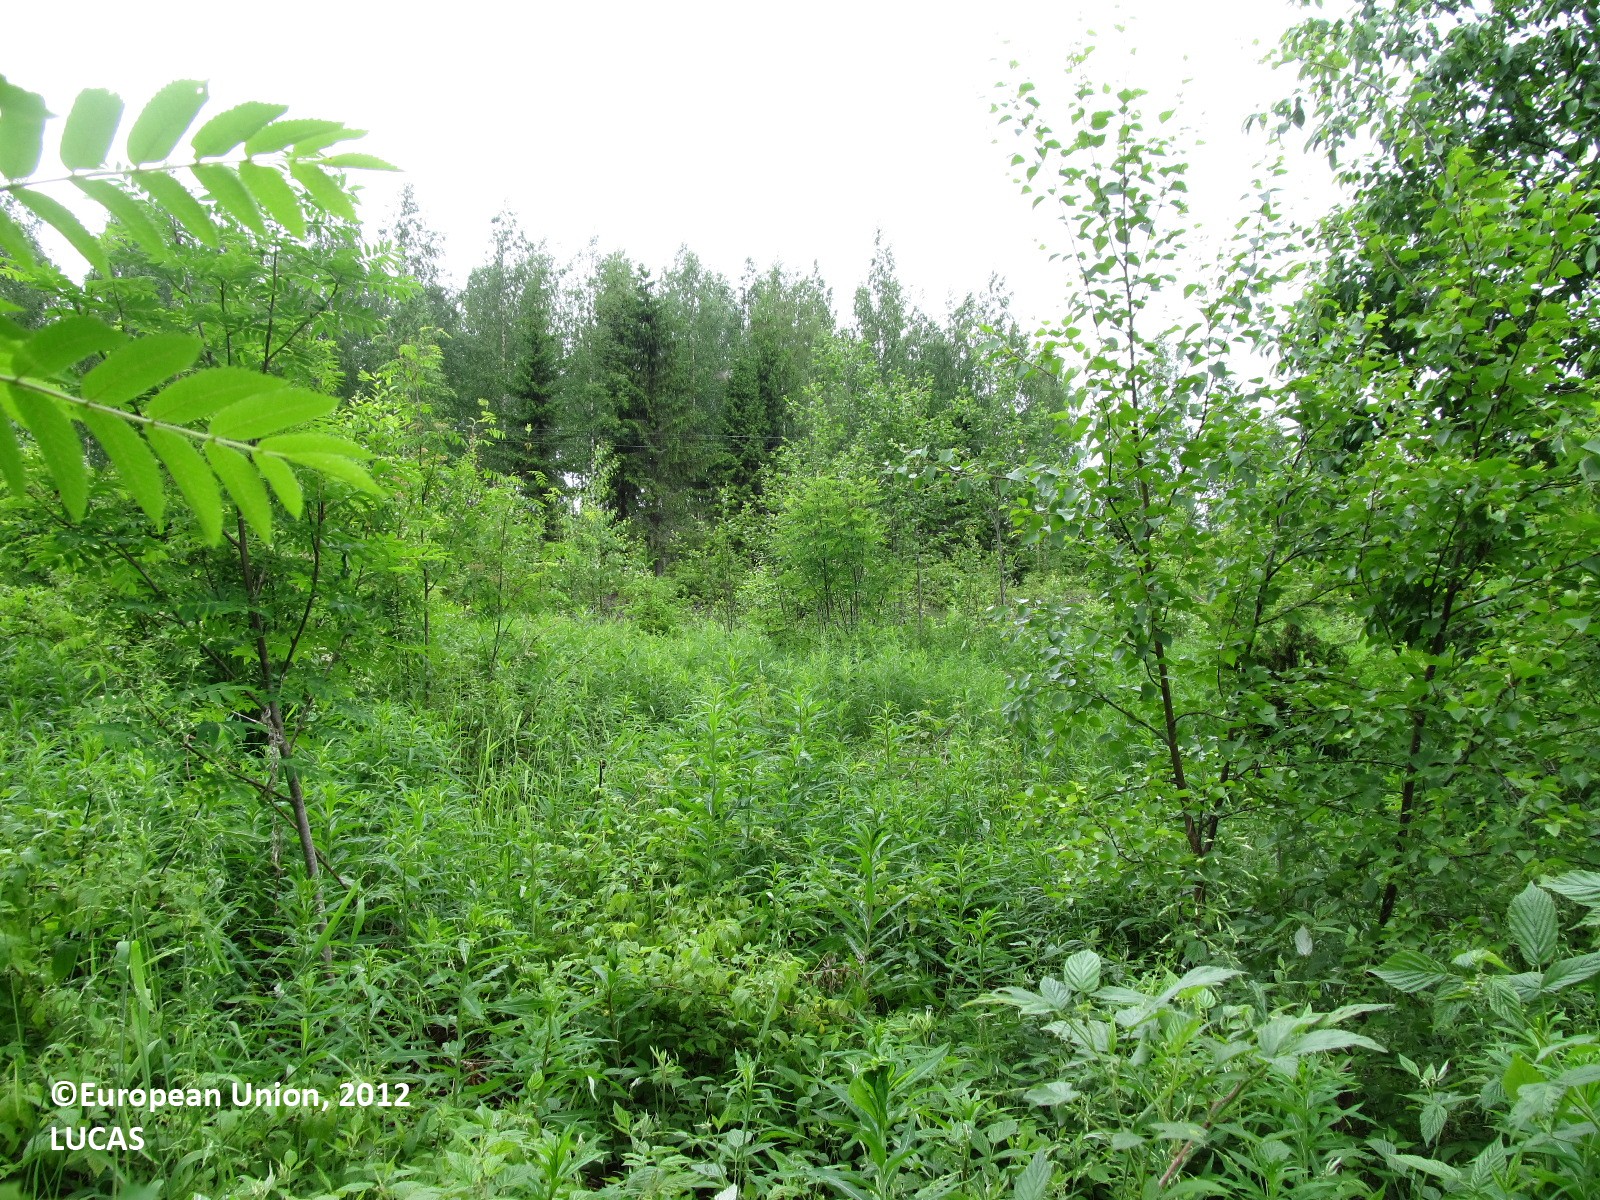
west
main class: Woodland
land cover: Broadleaved woodland
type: boreal forest
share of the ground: 50 - 75 %
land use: Forestry
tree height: < 5 m
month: June
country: FI
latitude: 63.1886
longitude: 27.6721
